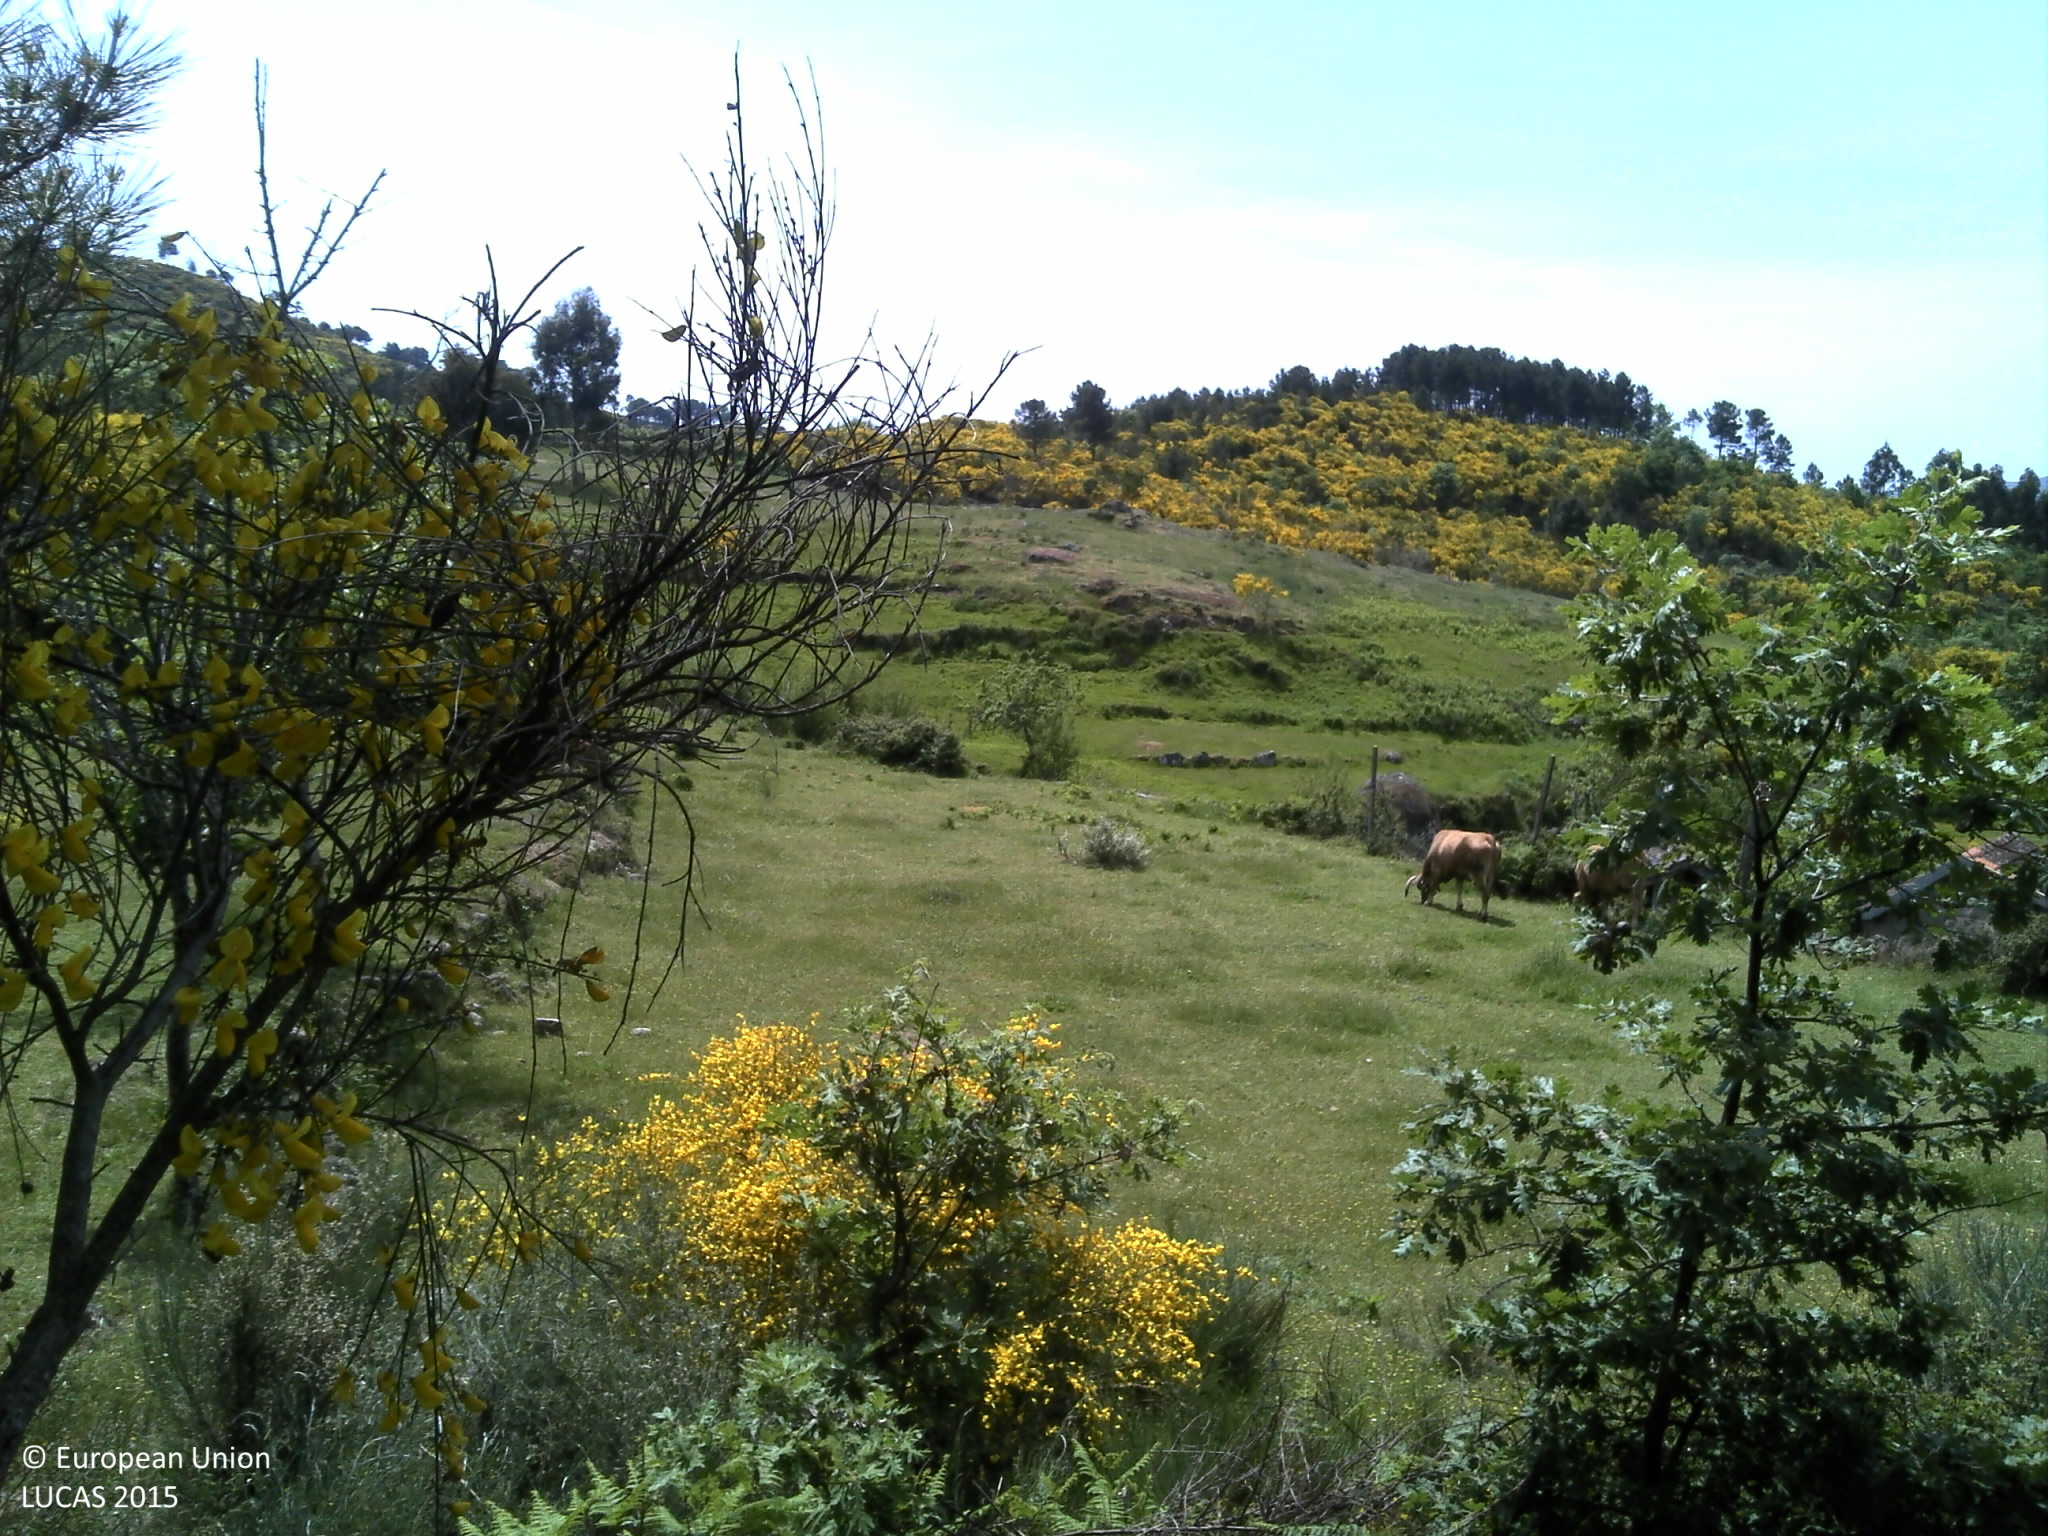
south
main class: Woodland
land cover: Pine dominated coniferous woodland
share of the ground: 50 - 75 %
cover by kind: coniferous forest trees 60 %, shrubs 25 %, unconsolidated bare surface 10 %, consolidated bare surface 5 %
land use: Forestry
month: May
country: PT
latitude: 41.0549
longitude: -8.0417
